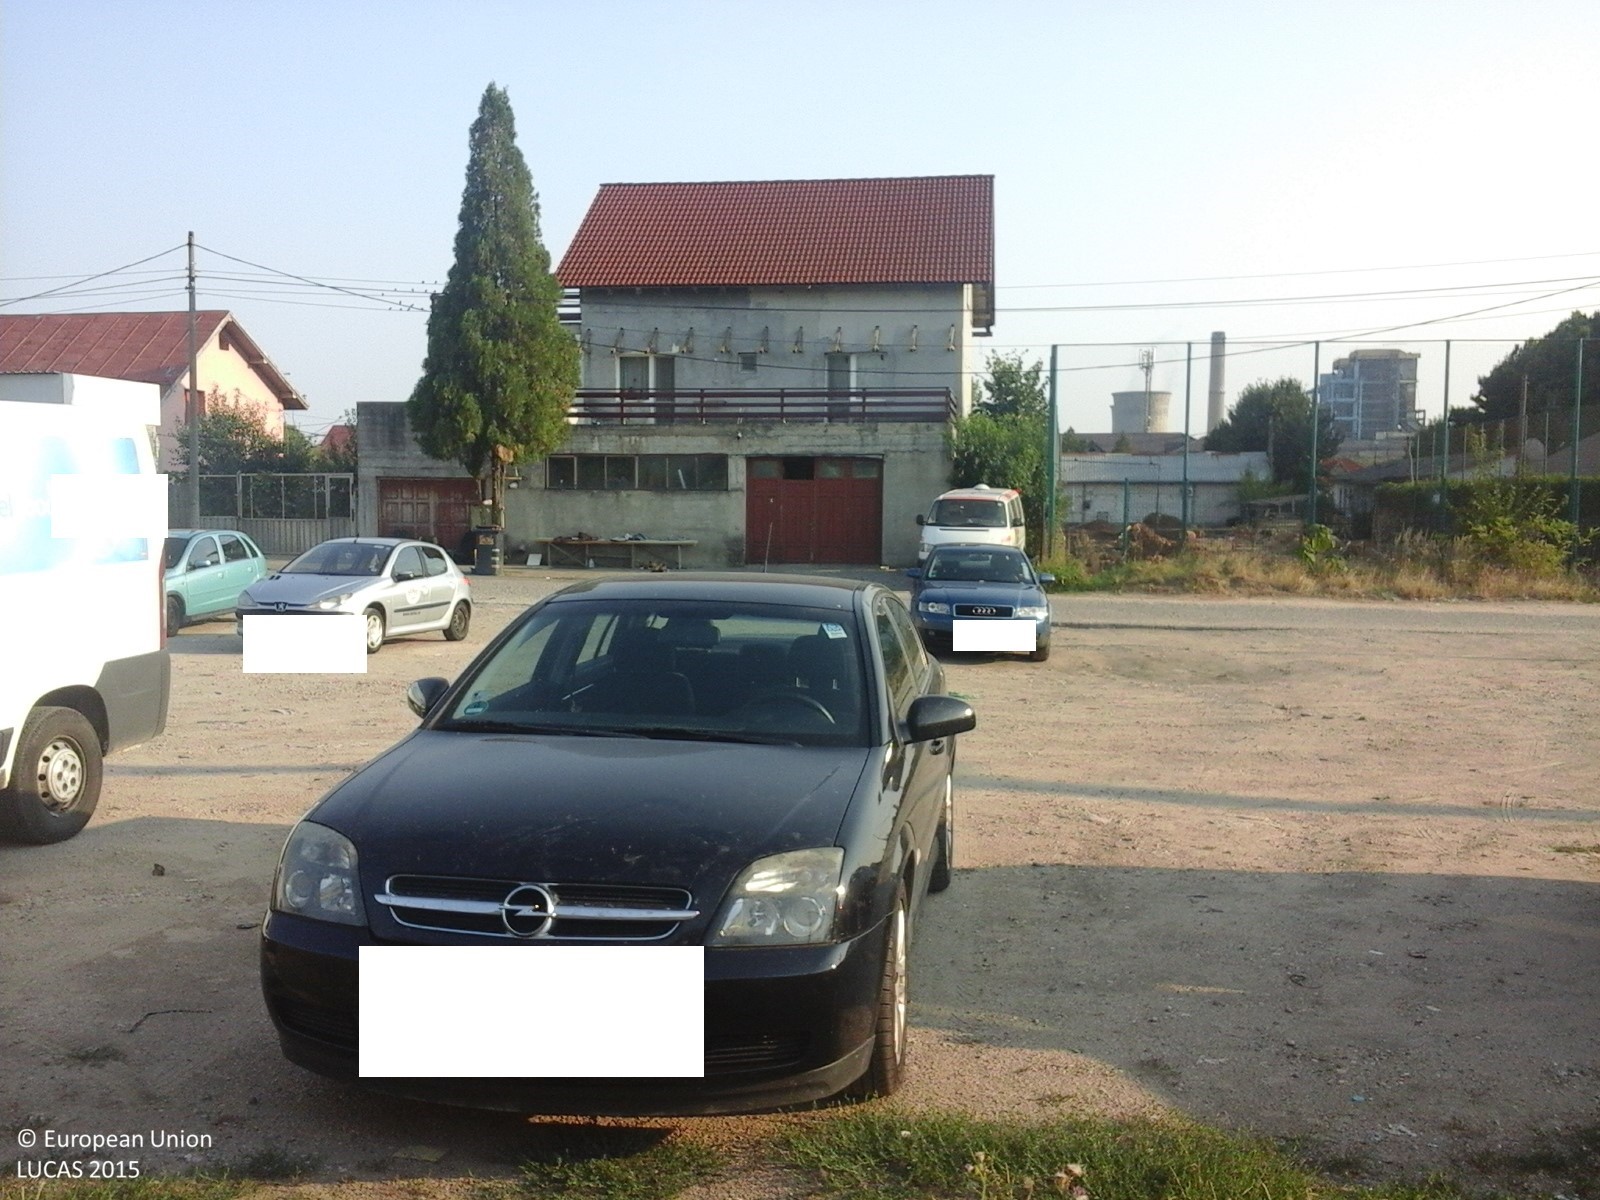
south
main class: Grassland
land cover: Spontaneously vegetated surfaces
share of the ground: > 75 %
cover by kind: herbaceous plants 100 %
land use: Residential
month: August
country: RO
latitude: 44.3528
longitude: 23.8198
